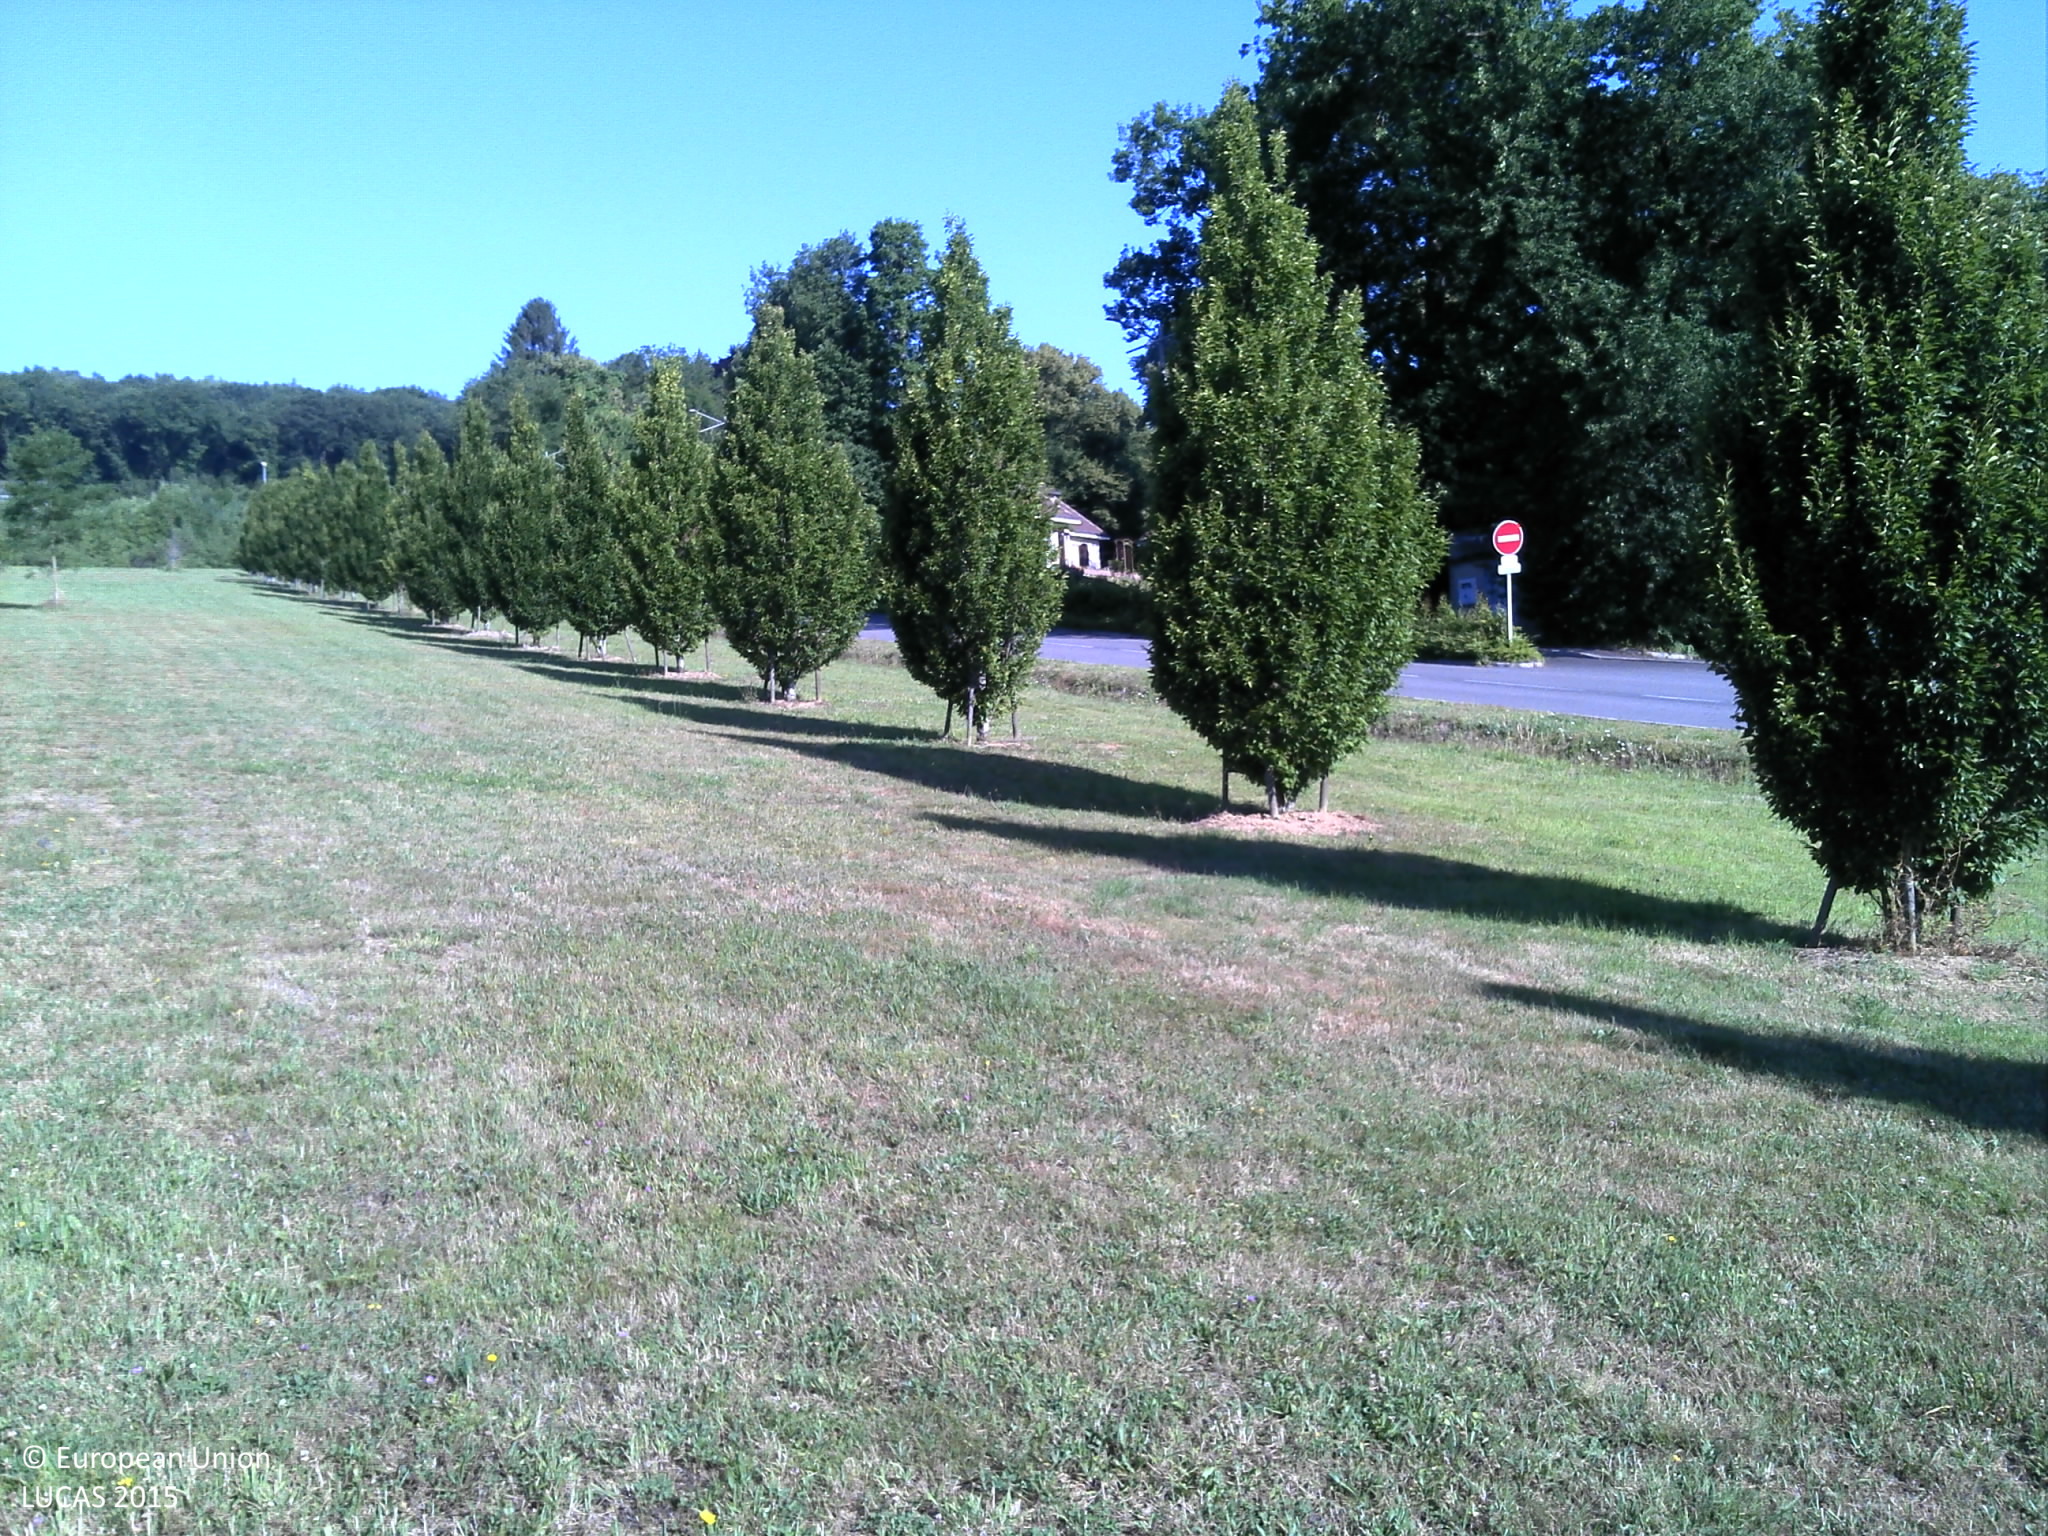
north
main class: Grassland
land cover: Grassland with sparse tree/shrub cover
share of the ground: > 75 %
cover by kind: herbaceous plants 95 %, broadleaved forest trees 5 %
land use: Semi-natural and natural areas not in use
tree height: < 5 m
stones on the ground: > 50 %
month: June
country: FR
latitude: 49.9881
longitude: 4.6824
